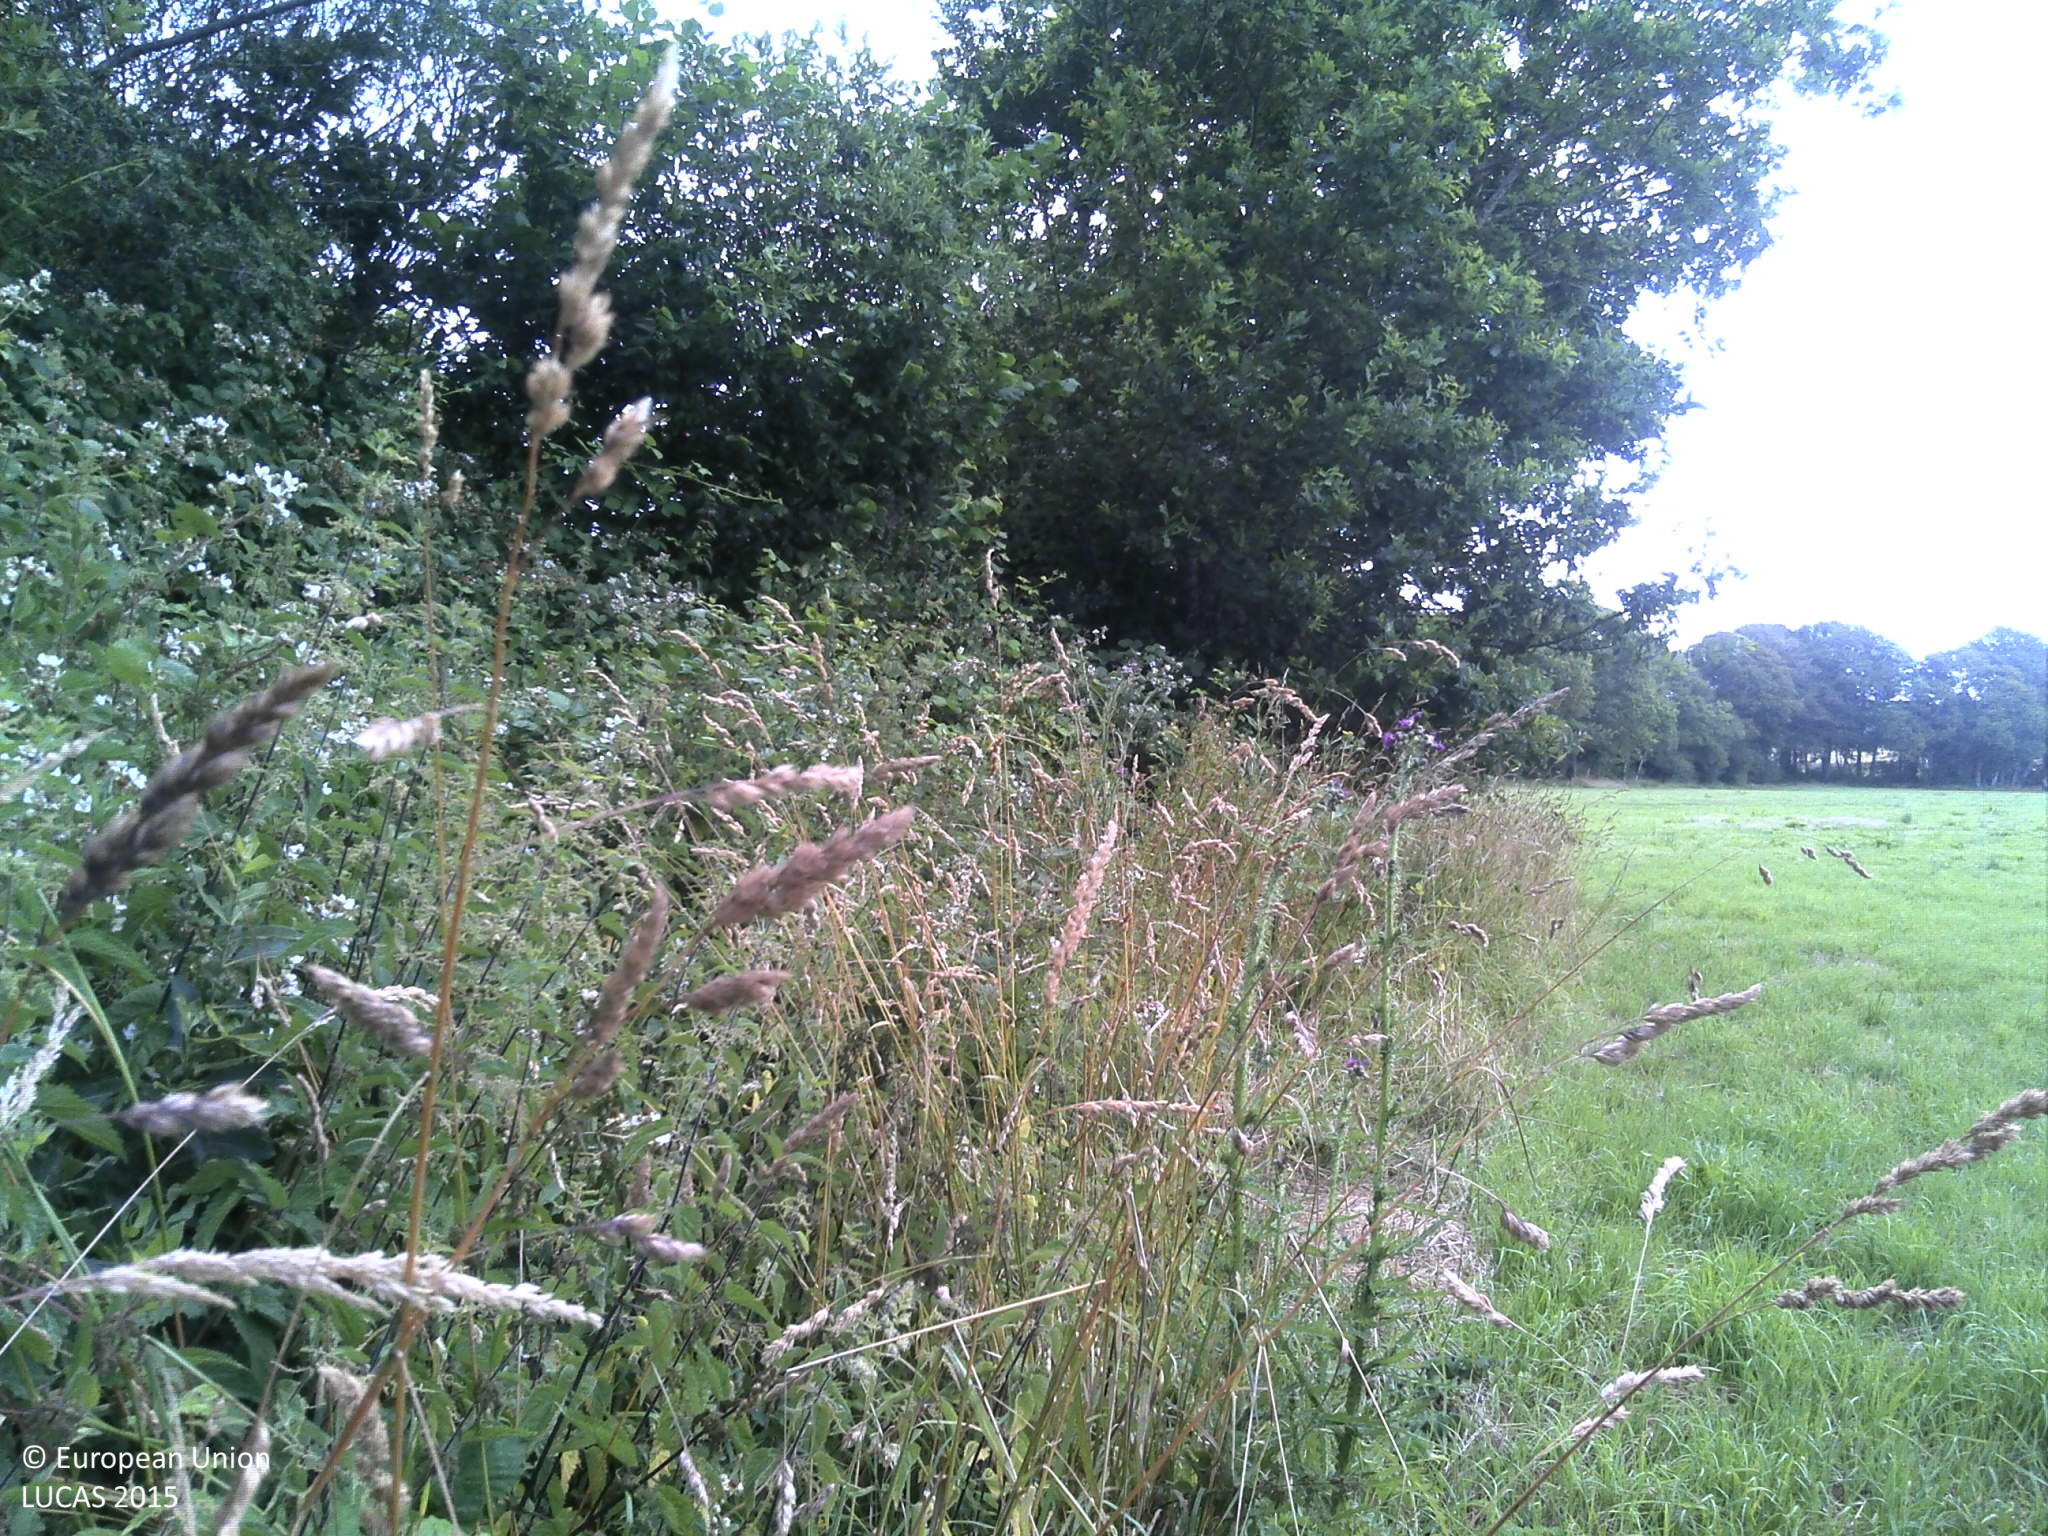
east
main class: Woodland
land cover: Broadleaved woodland
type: acidophilous oak and oak-birch forest
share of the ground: > 75 %
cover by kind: broadleaved forest trees 90 %, shrubs 5 %, herbaceous plants 5 %
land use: Agriculture (excluding fallow land and kitchen gardens)
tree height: > 5 m
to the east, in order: Broadleaved woodland; Electric lines; Broadleaved woodland; Grassland without tree/shrub cover; Broadleaved woodland; Rivers and streams; Broadleaved woodland; Fences; Grassland without tree/shrub cover; Fences; Rivers and streams; Broadleaved woodland; Grassland without tree/shrub cover
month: July
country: FR
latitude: 48.1544
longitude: -4.2197
